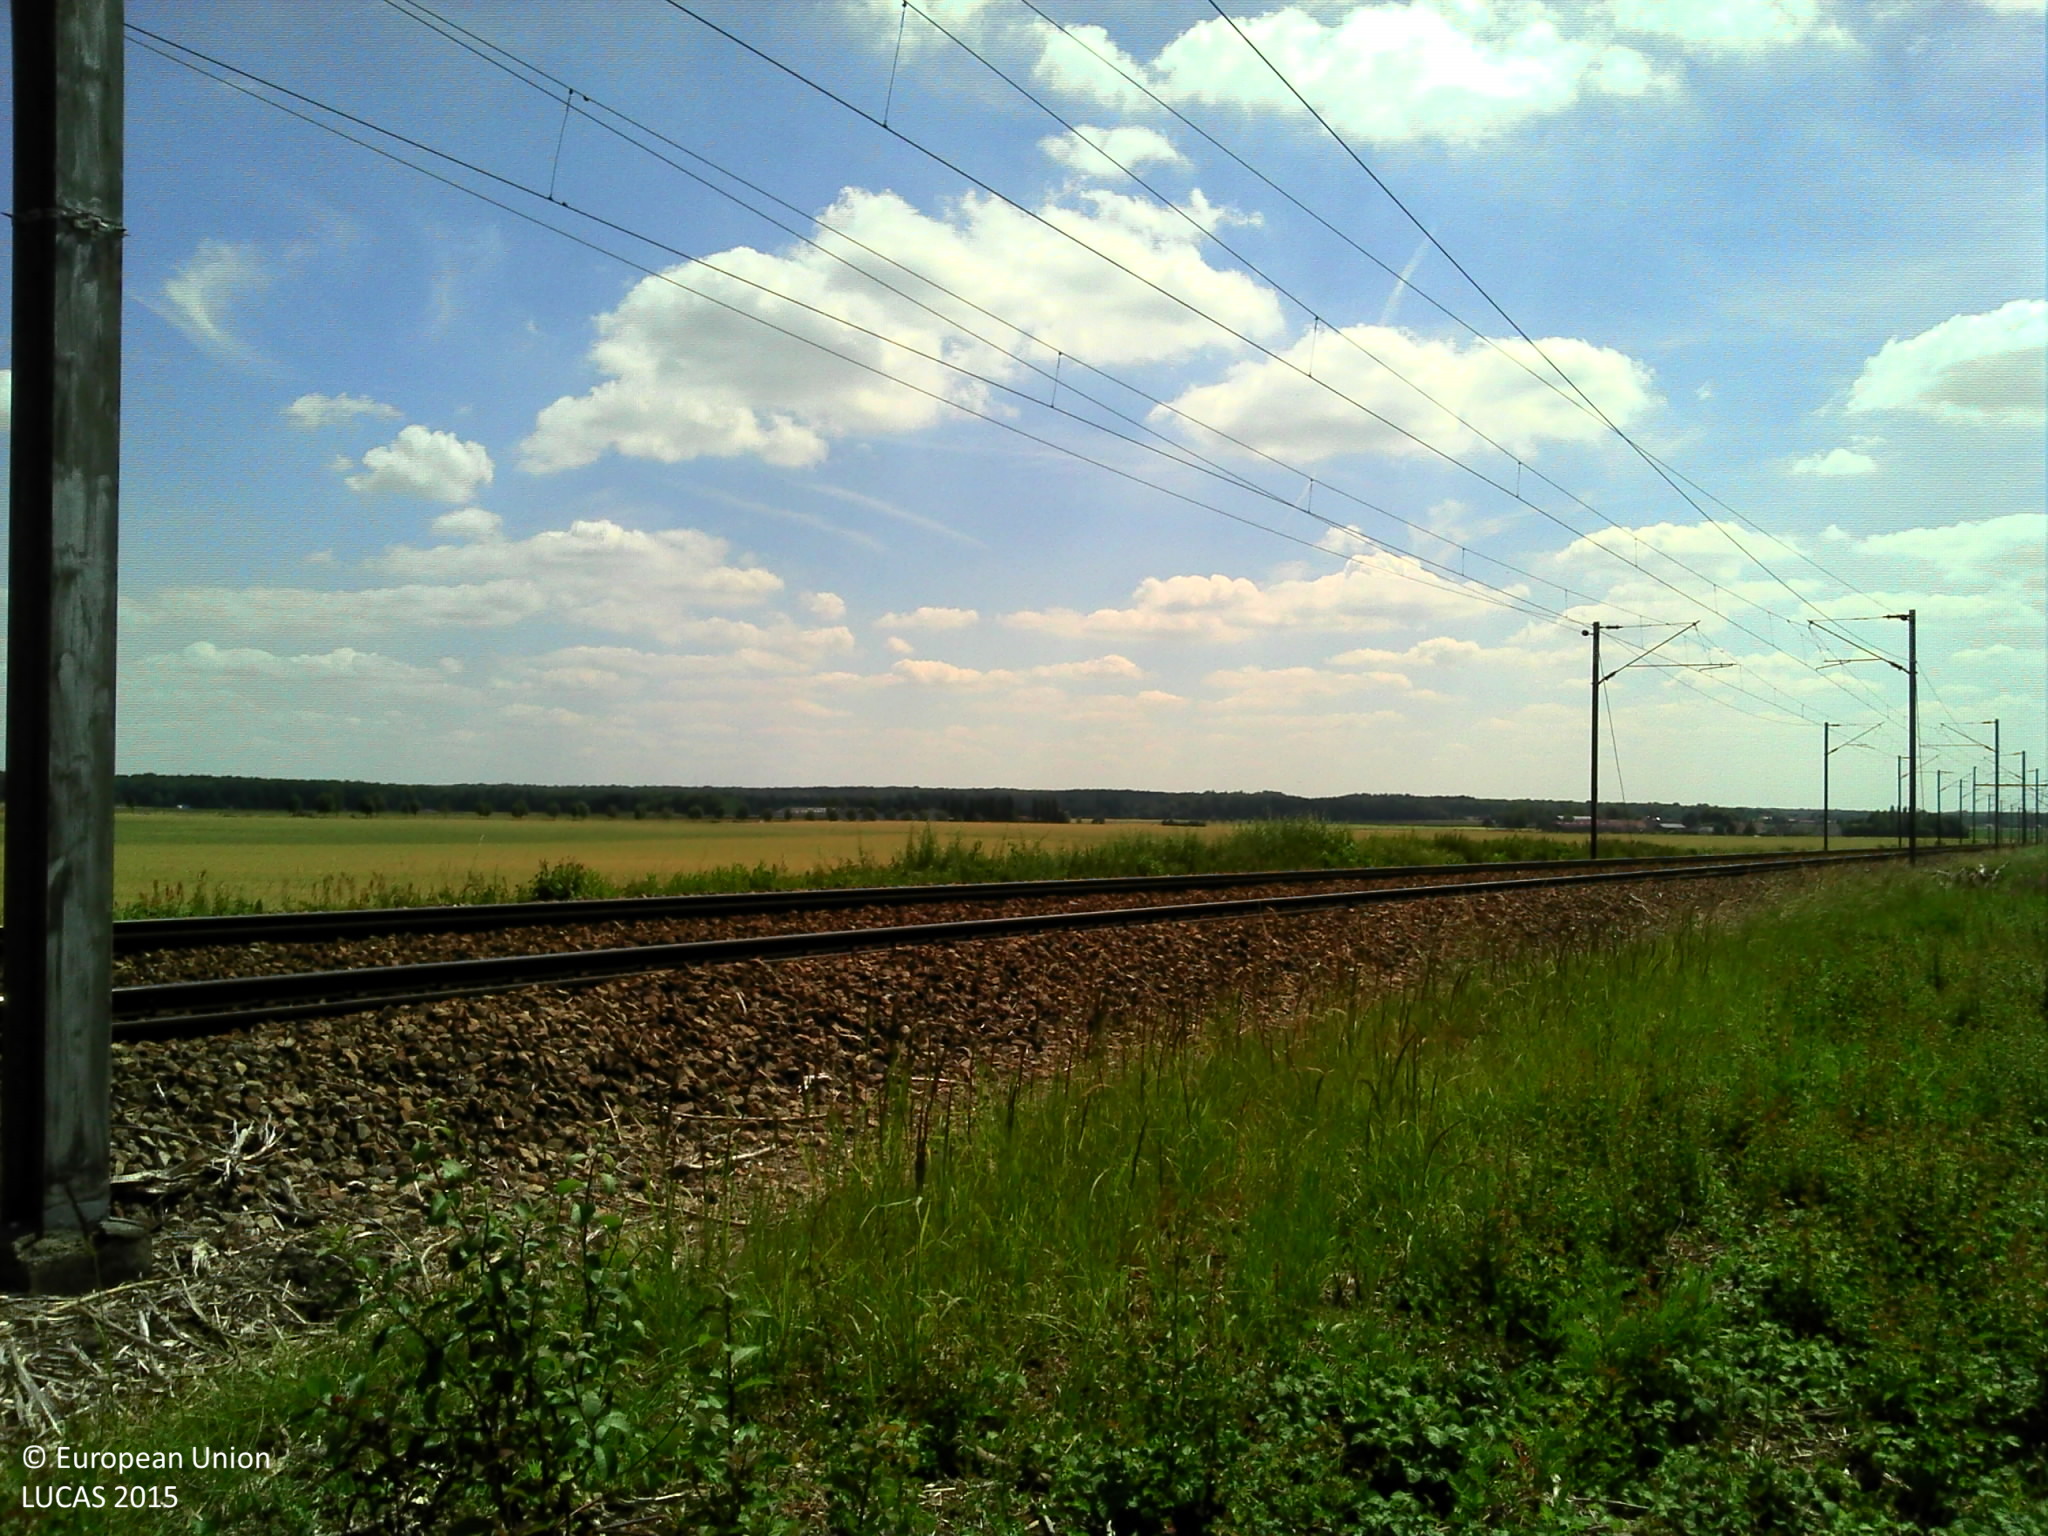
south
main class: Grassland
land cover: Spontaneously vegetated surfaces
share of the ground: > 75 %
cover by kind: herbaceous plants 85 %, unconsolidated bare surface 10 %, shrubs 5 %
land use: Semi-natural and natural areas not in use
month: June
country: FR
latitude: 49.2203
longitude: 2.8645
